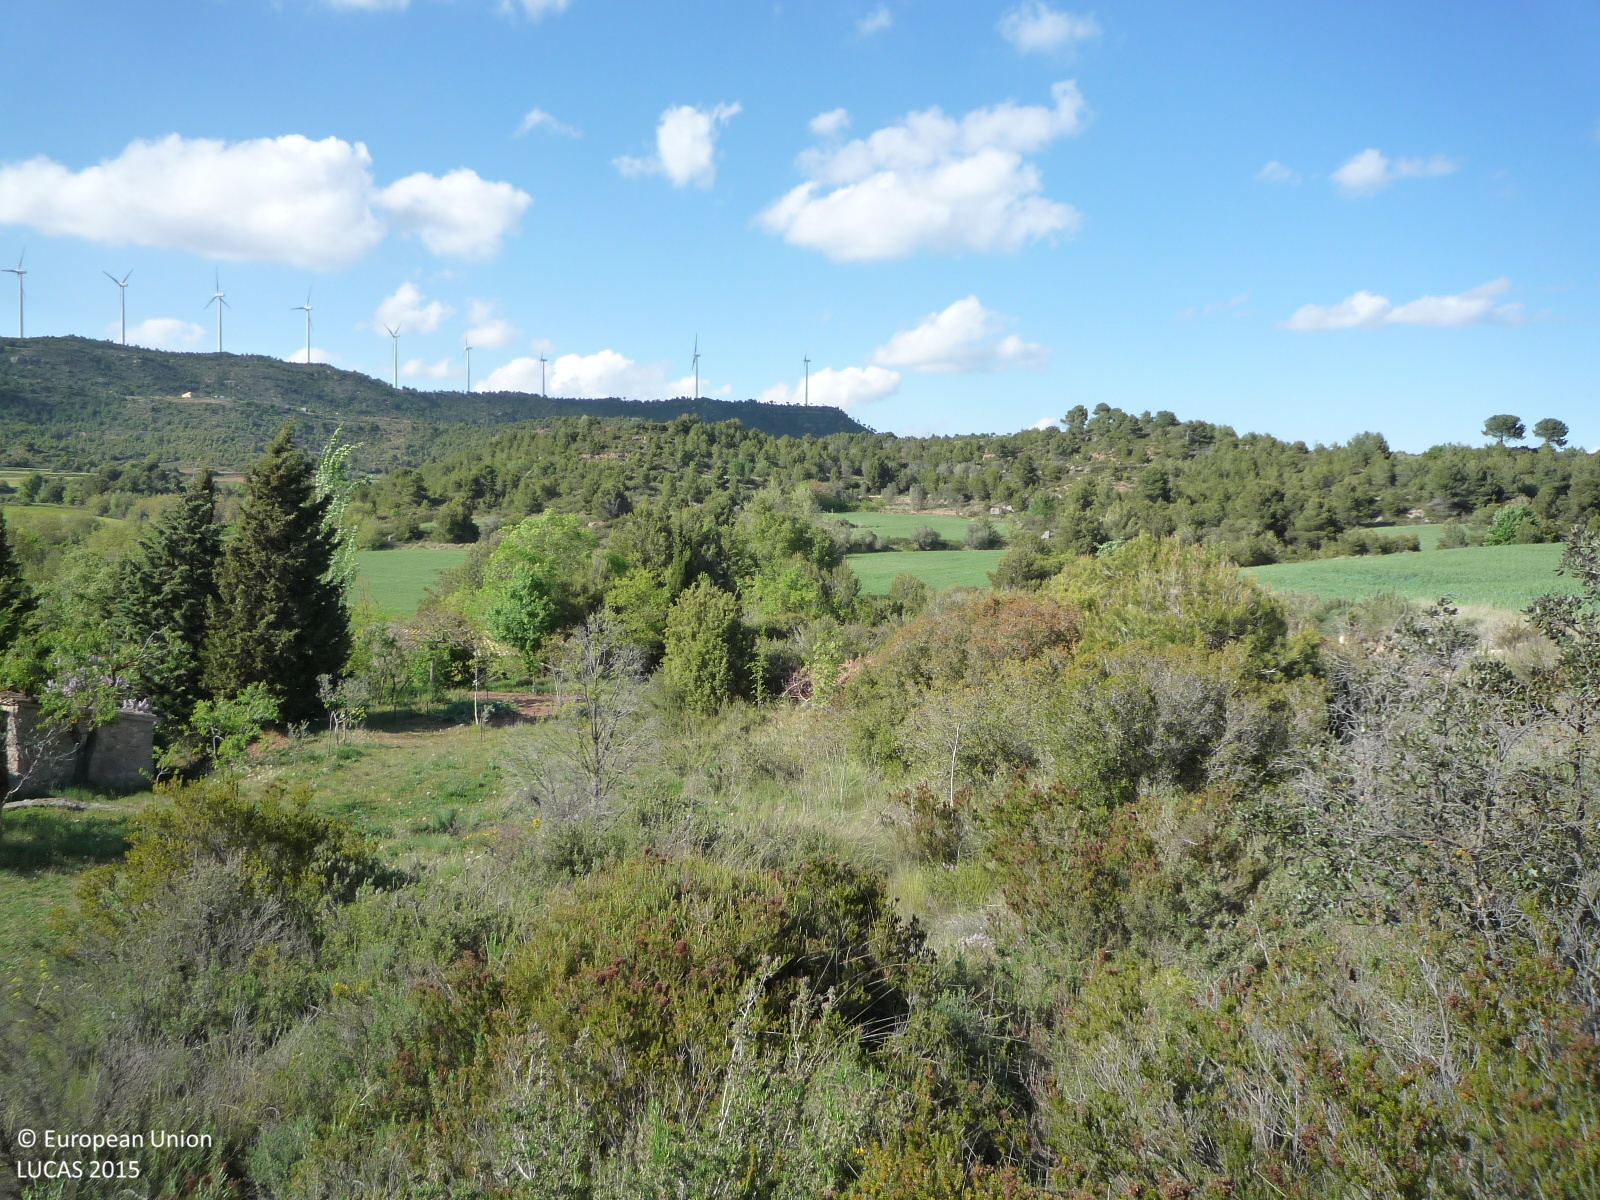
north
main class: Shrubland
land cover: Shrubland with sparse tree cover
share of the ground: > 75 %
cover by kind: shrubs 95 %, coniferous forest trees 5 %
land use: Semi-natural and natural areas not in use
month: April
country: ES
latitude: 41.6549
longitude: 1.6455
